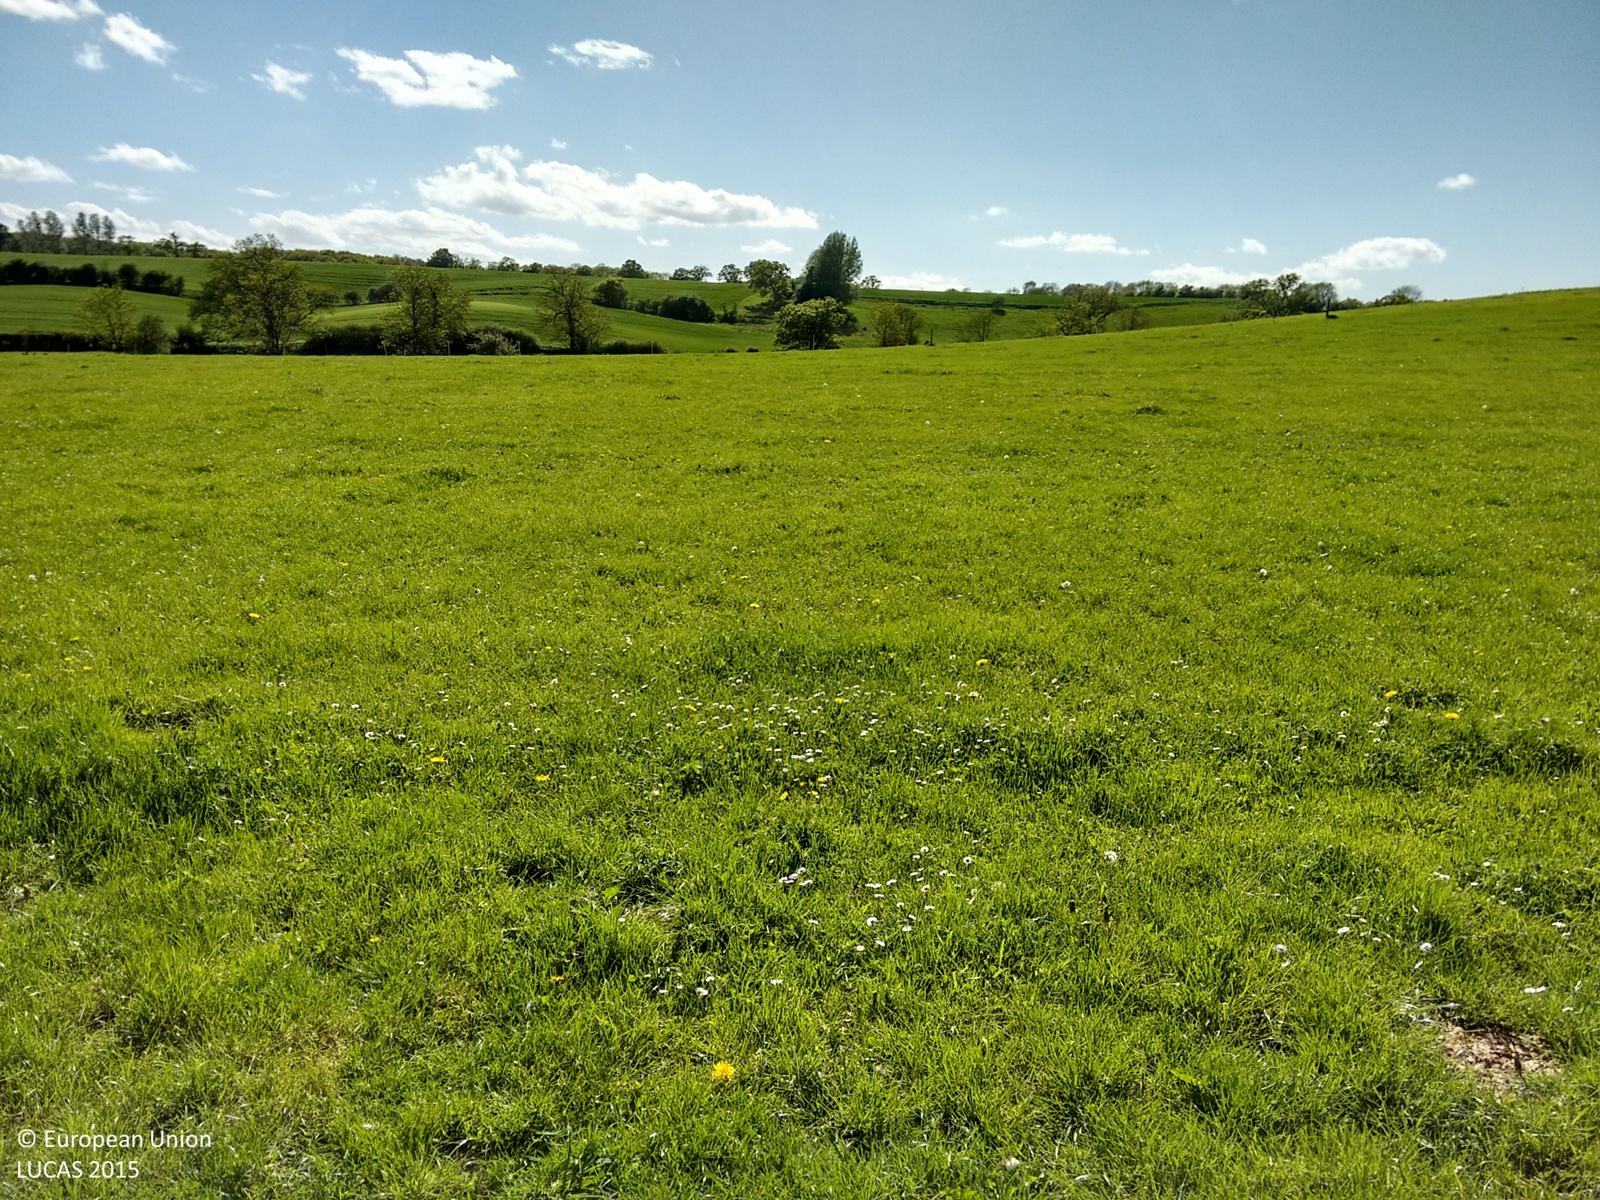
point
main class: Grassland
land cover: Grassland without tree/shrub cover
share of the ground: > 75 %
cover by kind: herbaceous plants 100 %
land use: Agriculture (excluding fallow land and kitchen gardens)
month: May
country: GB
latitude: 52.2510
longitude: -1.6991
